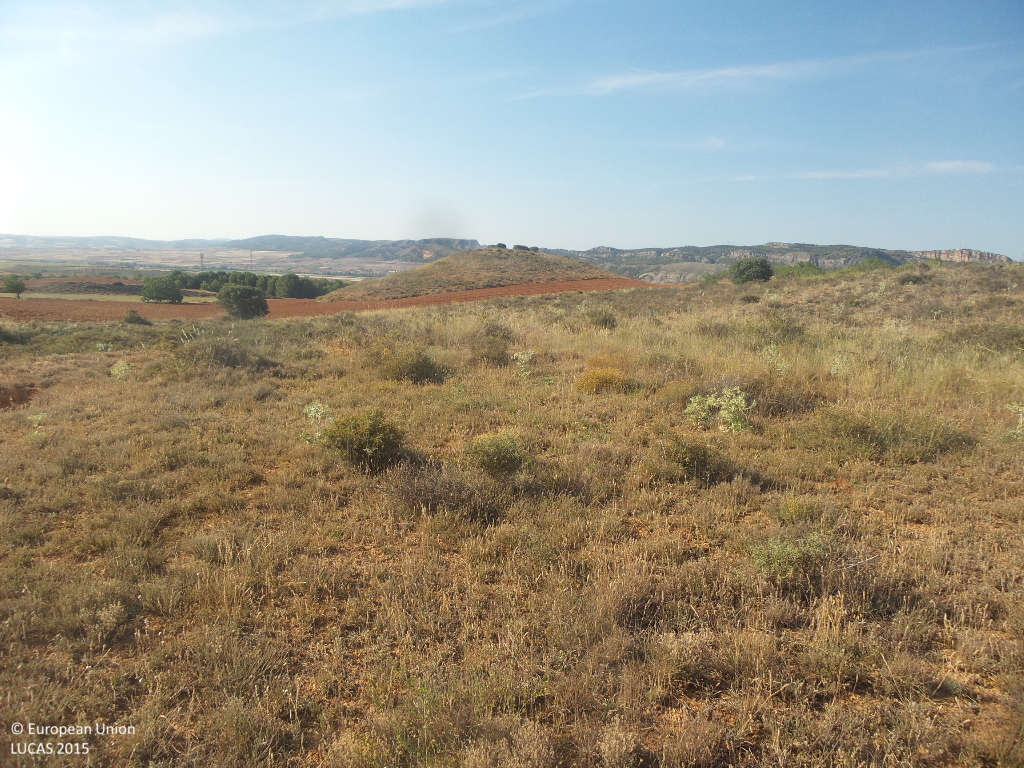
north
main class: Shrubland
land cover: Shrubland without tree cover
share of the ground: 50 - 75 %
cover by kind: shrubs 60 %, unconsolidated bare surface 30 %, herbaceous plants 10 %
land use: Semi-natural and natural areas not in use
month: July
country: ES
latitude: 41.2743
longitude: -1.9053
